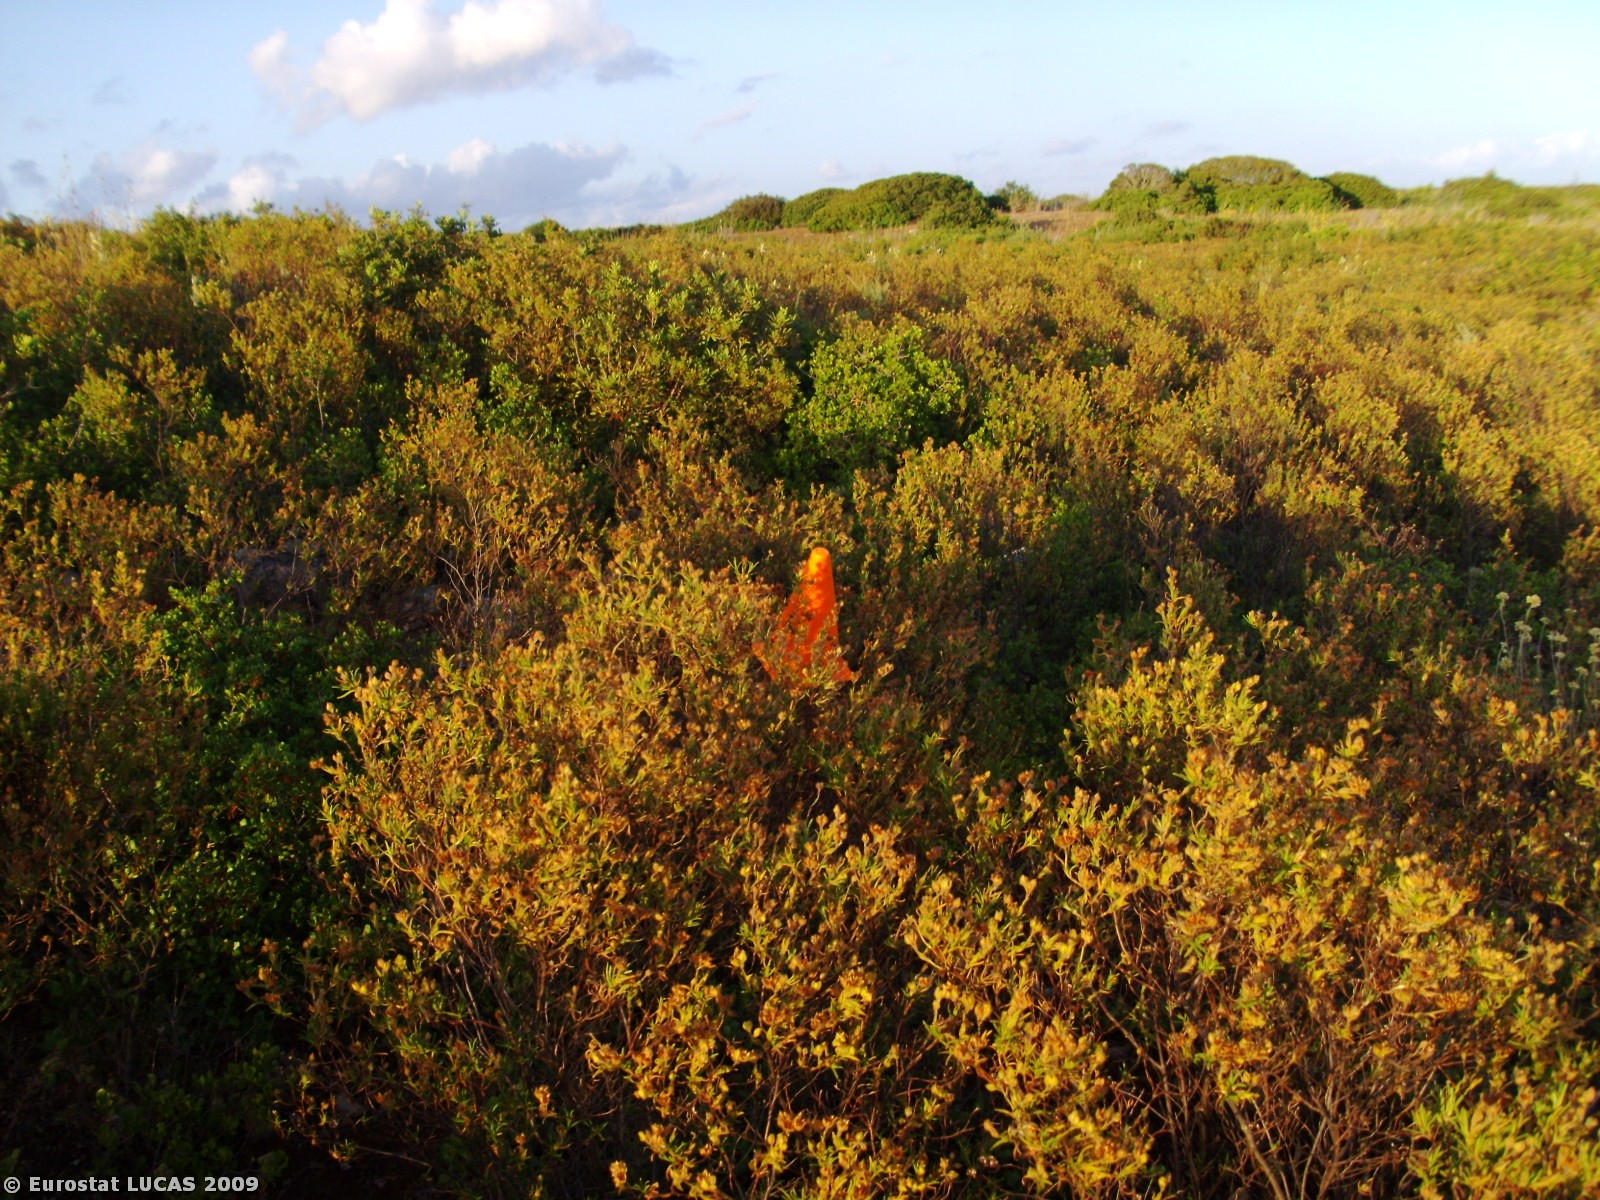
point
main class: Shrubland
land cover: Shrubland without tree cover
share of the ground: > 75 %
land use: Unused
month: June
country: PT
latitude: 37.1523
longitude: -8.7096
